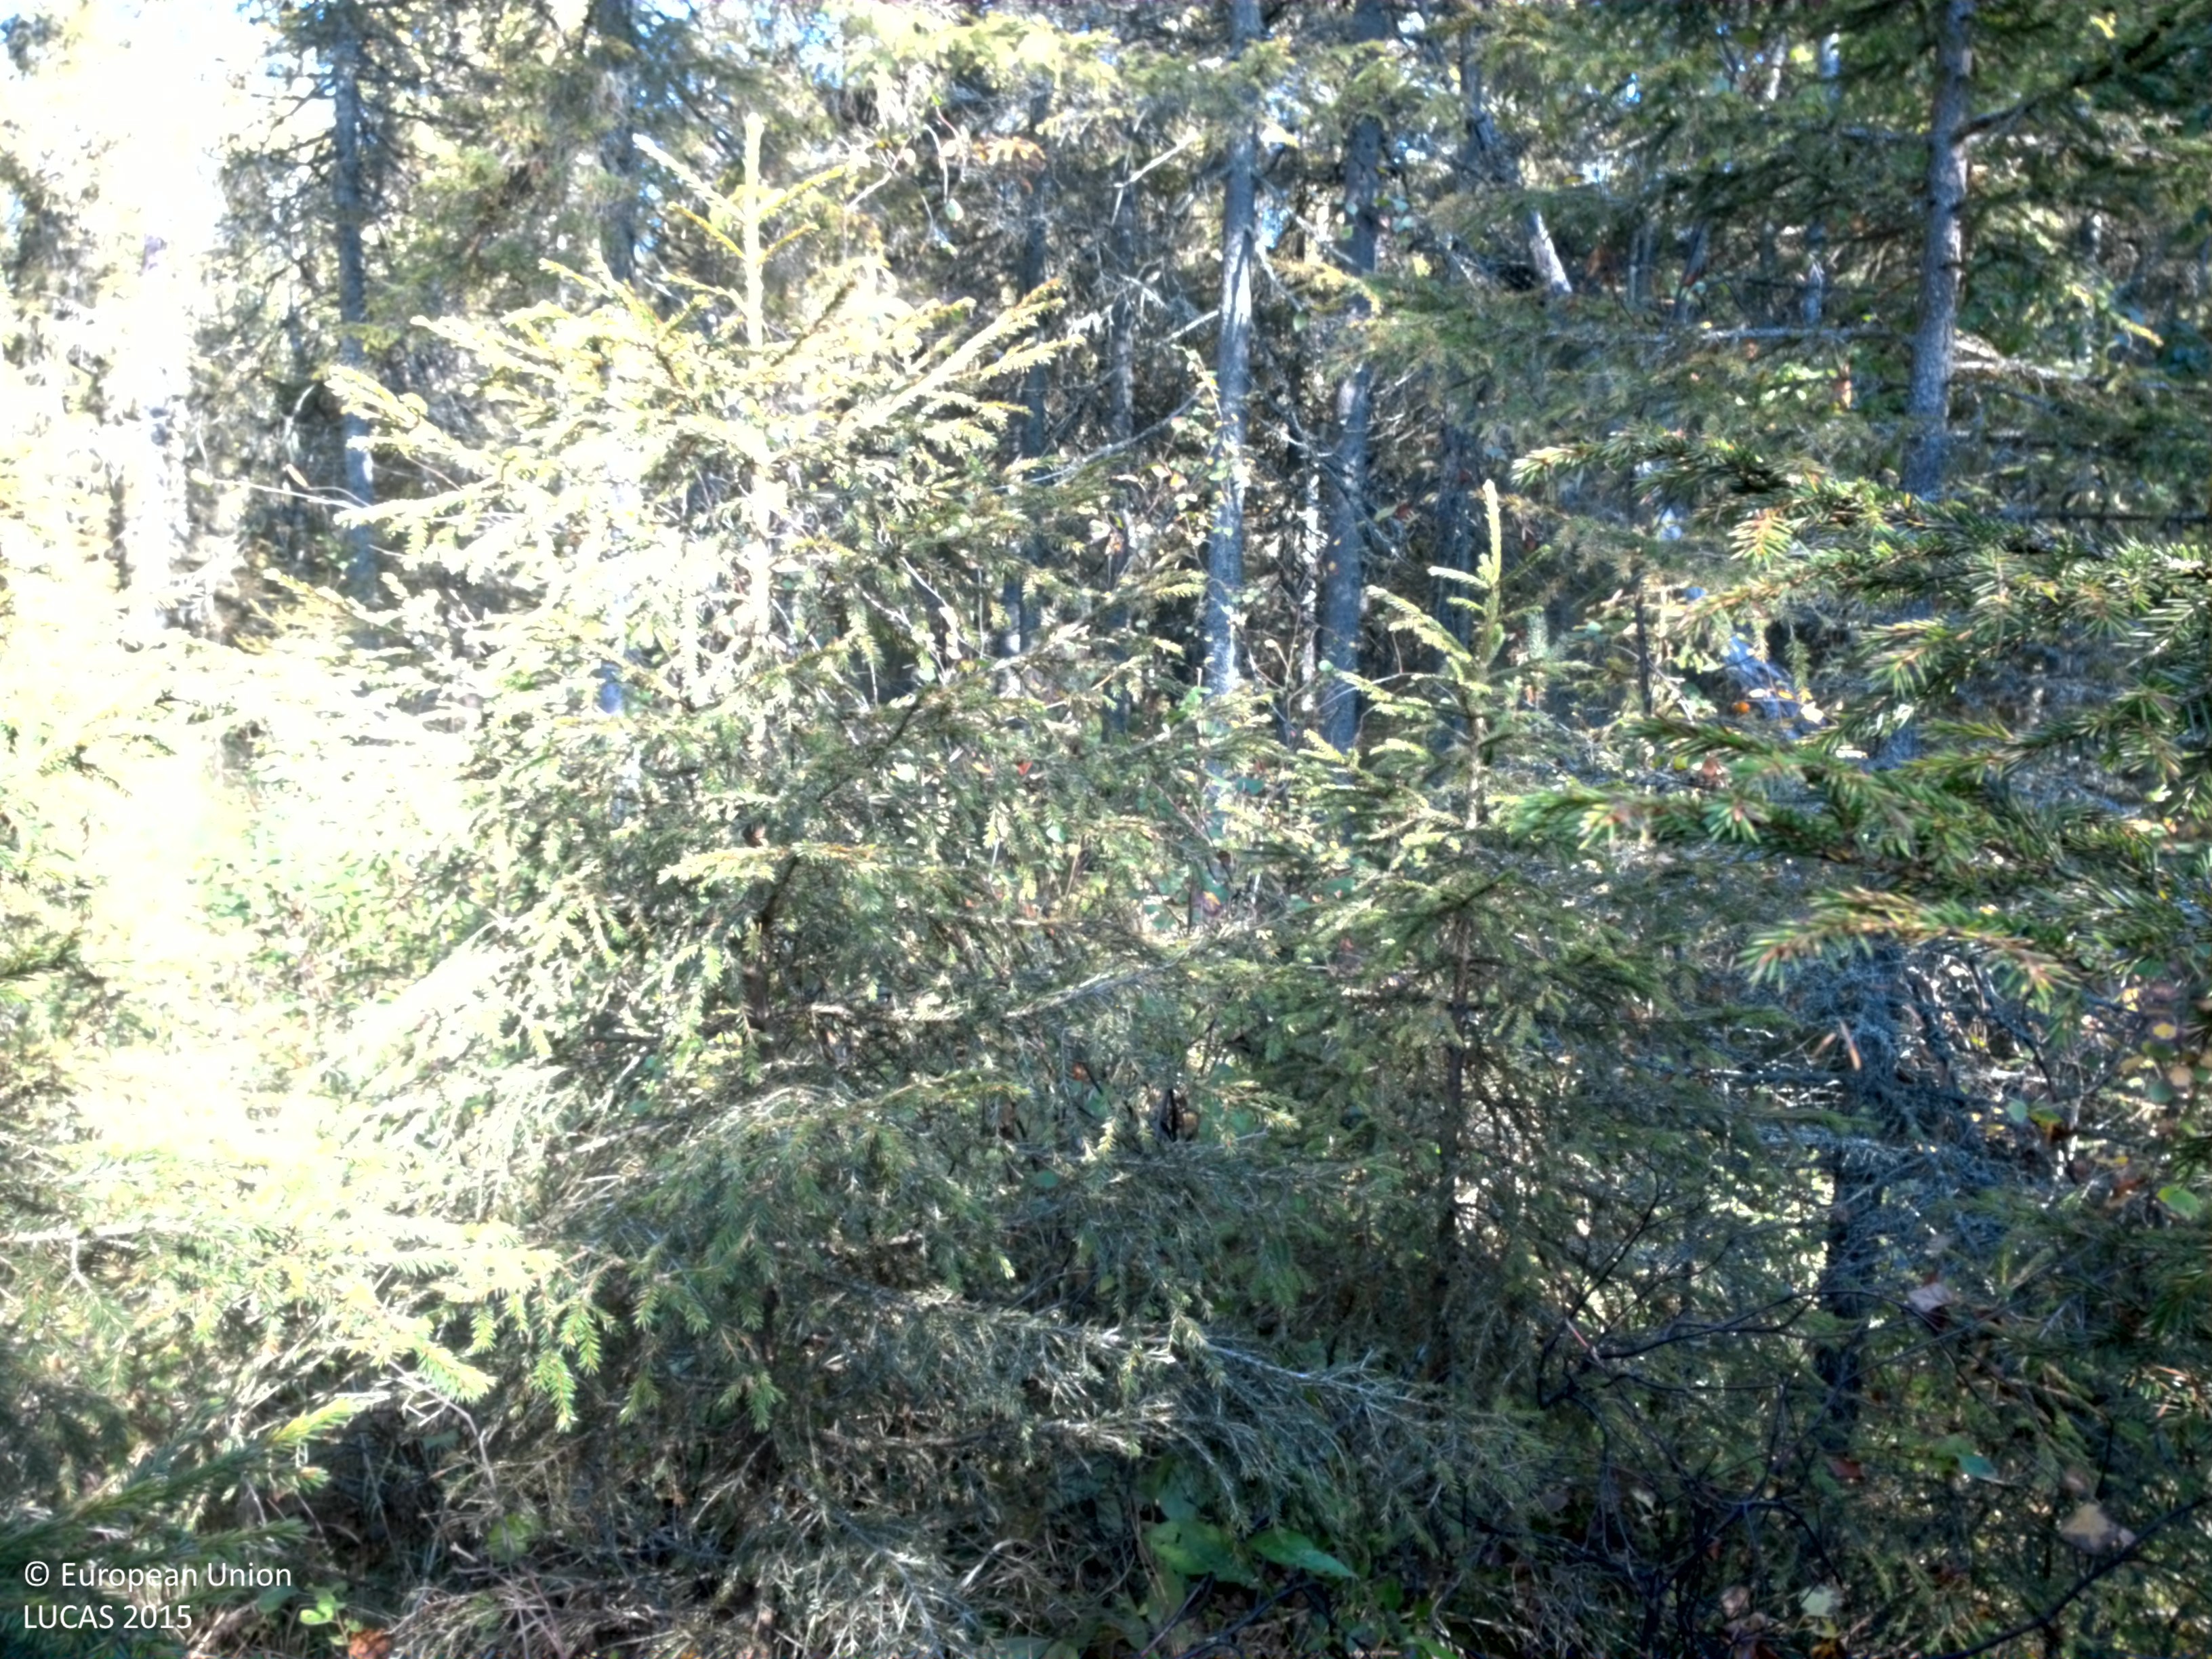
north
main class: Woodland
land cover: Spruce dominated coniferous woodland
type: boreal forest
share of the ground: 25 - 50 %
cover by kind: coniferous forest trees 35 %, shrubs 35 %, broadleaved forest trees 10 %, herbaceous plants 10 %, lichens and mosses 10 %
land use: Forestry
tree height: > 5 m
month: September
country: SE
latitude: 65.8589
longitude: 22.5805
